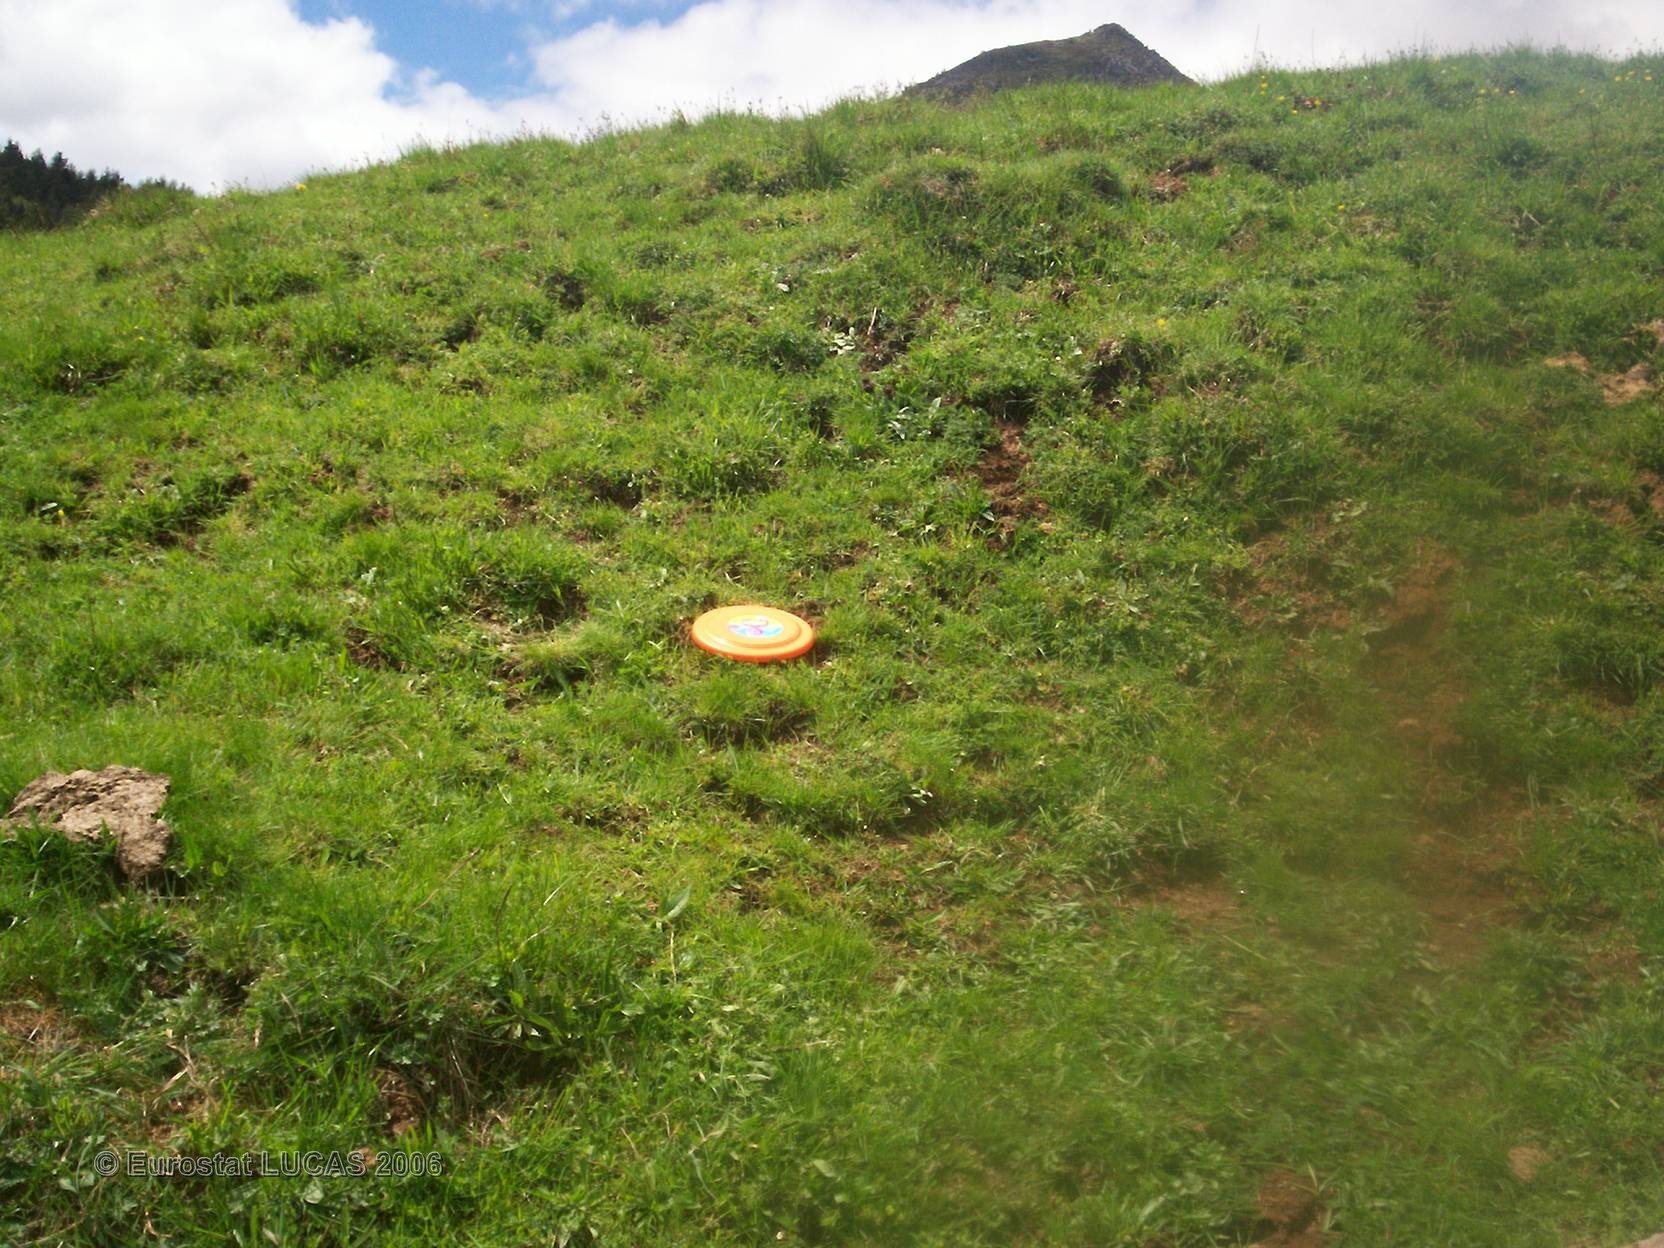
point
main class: Grassland
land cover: Grassland without tree/shrub cover
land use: Agriculture (excluding fallow land and kitchen gardens)
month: May
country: FR
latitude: 44.9122
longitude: 4.2165
